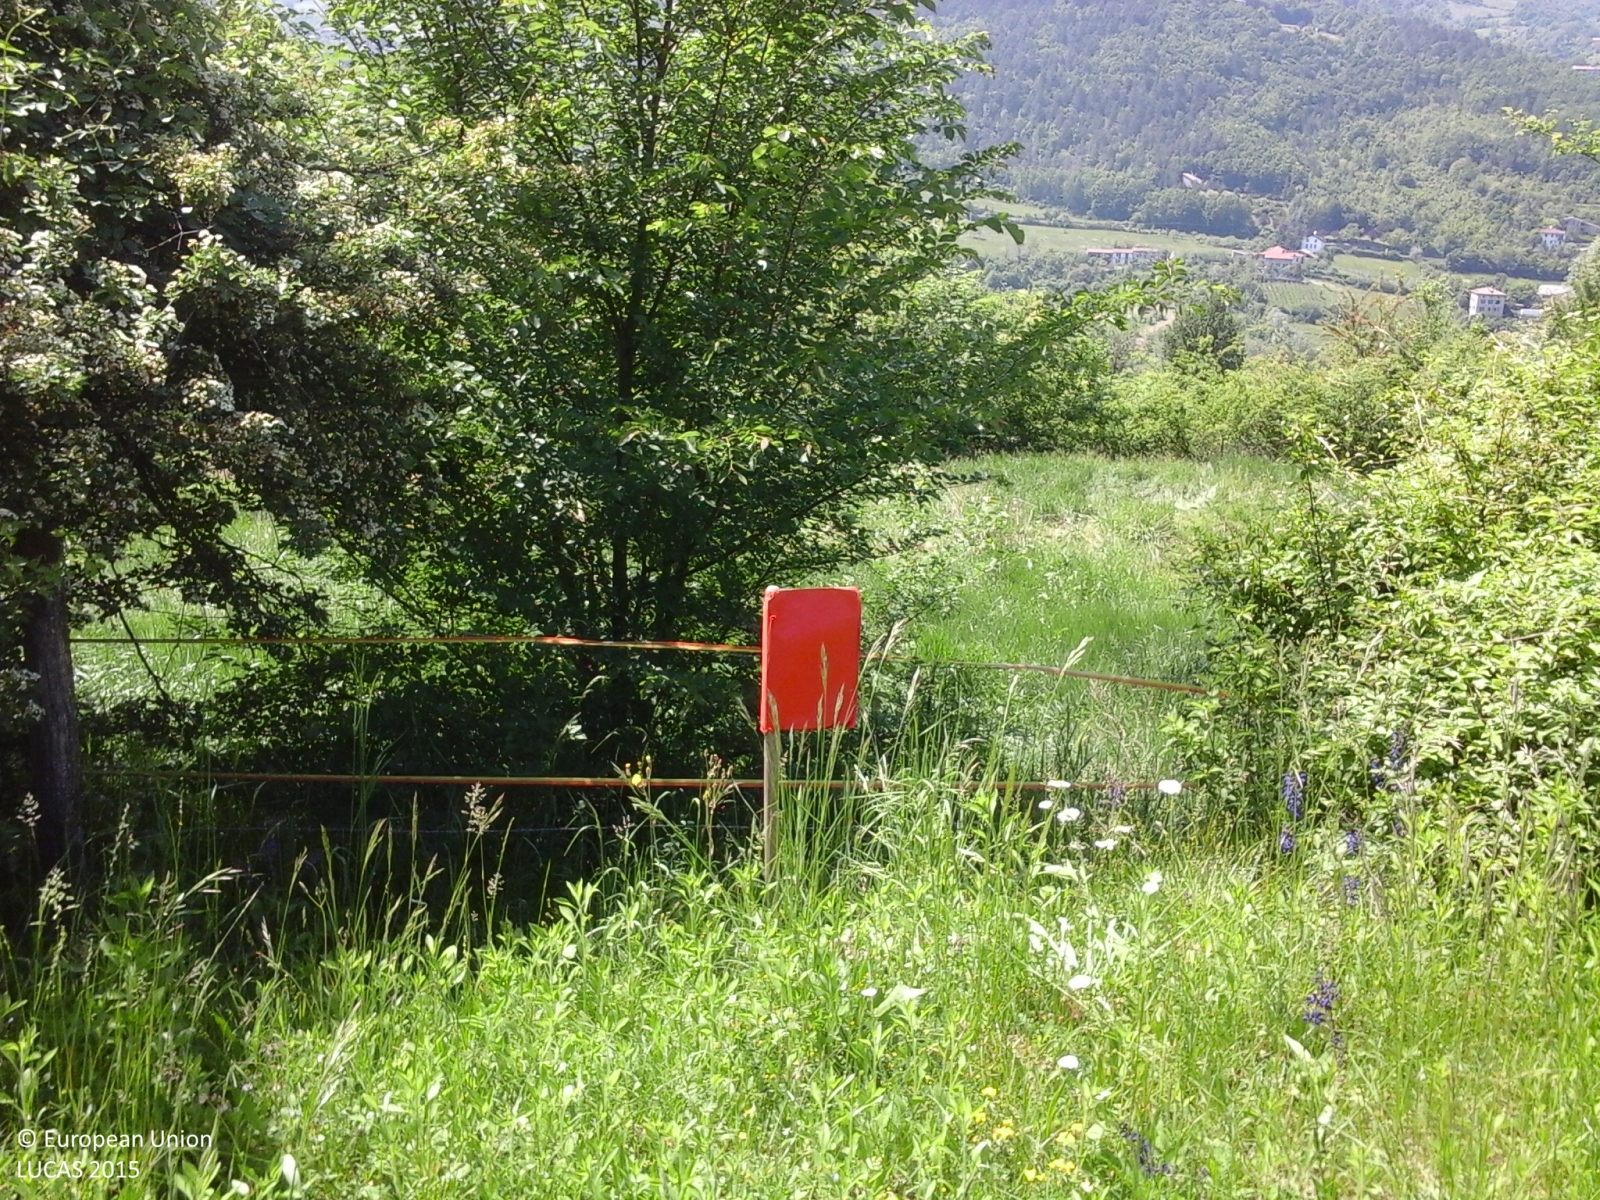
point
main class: Grassland
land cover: Grassland with sparse tree/shrub cover
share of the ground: > 75 %
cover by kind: herbaceous plants 90 %, broadleaved forest trees 5 %, shrubs 5 %
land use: Agriculture (excluding fallow land and kitchen gardens)
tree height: > 5 m
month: May
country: IT
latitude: 44.7646
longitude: 9.6092
